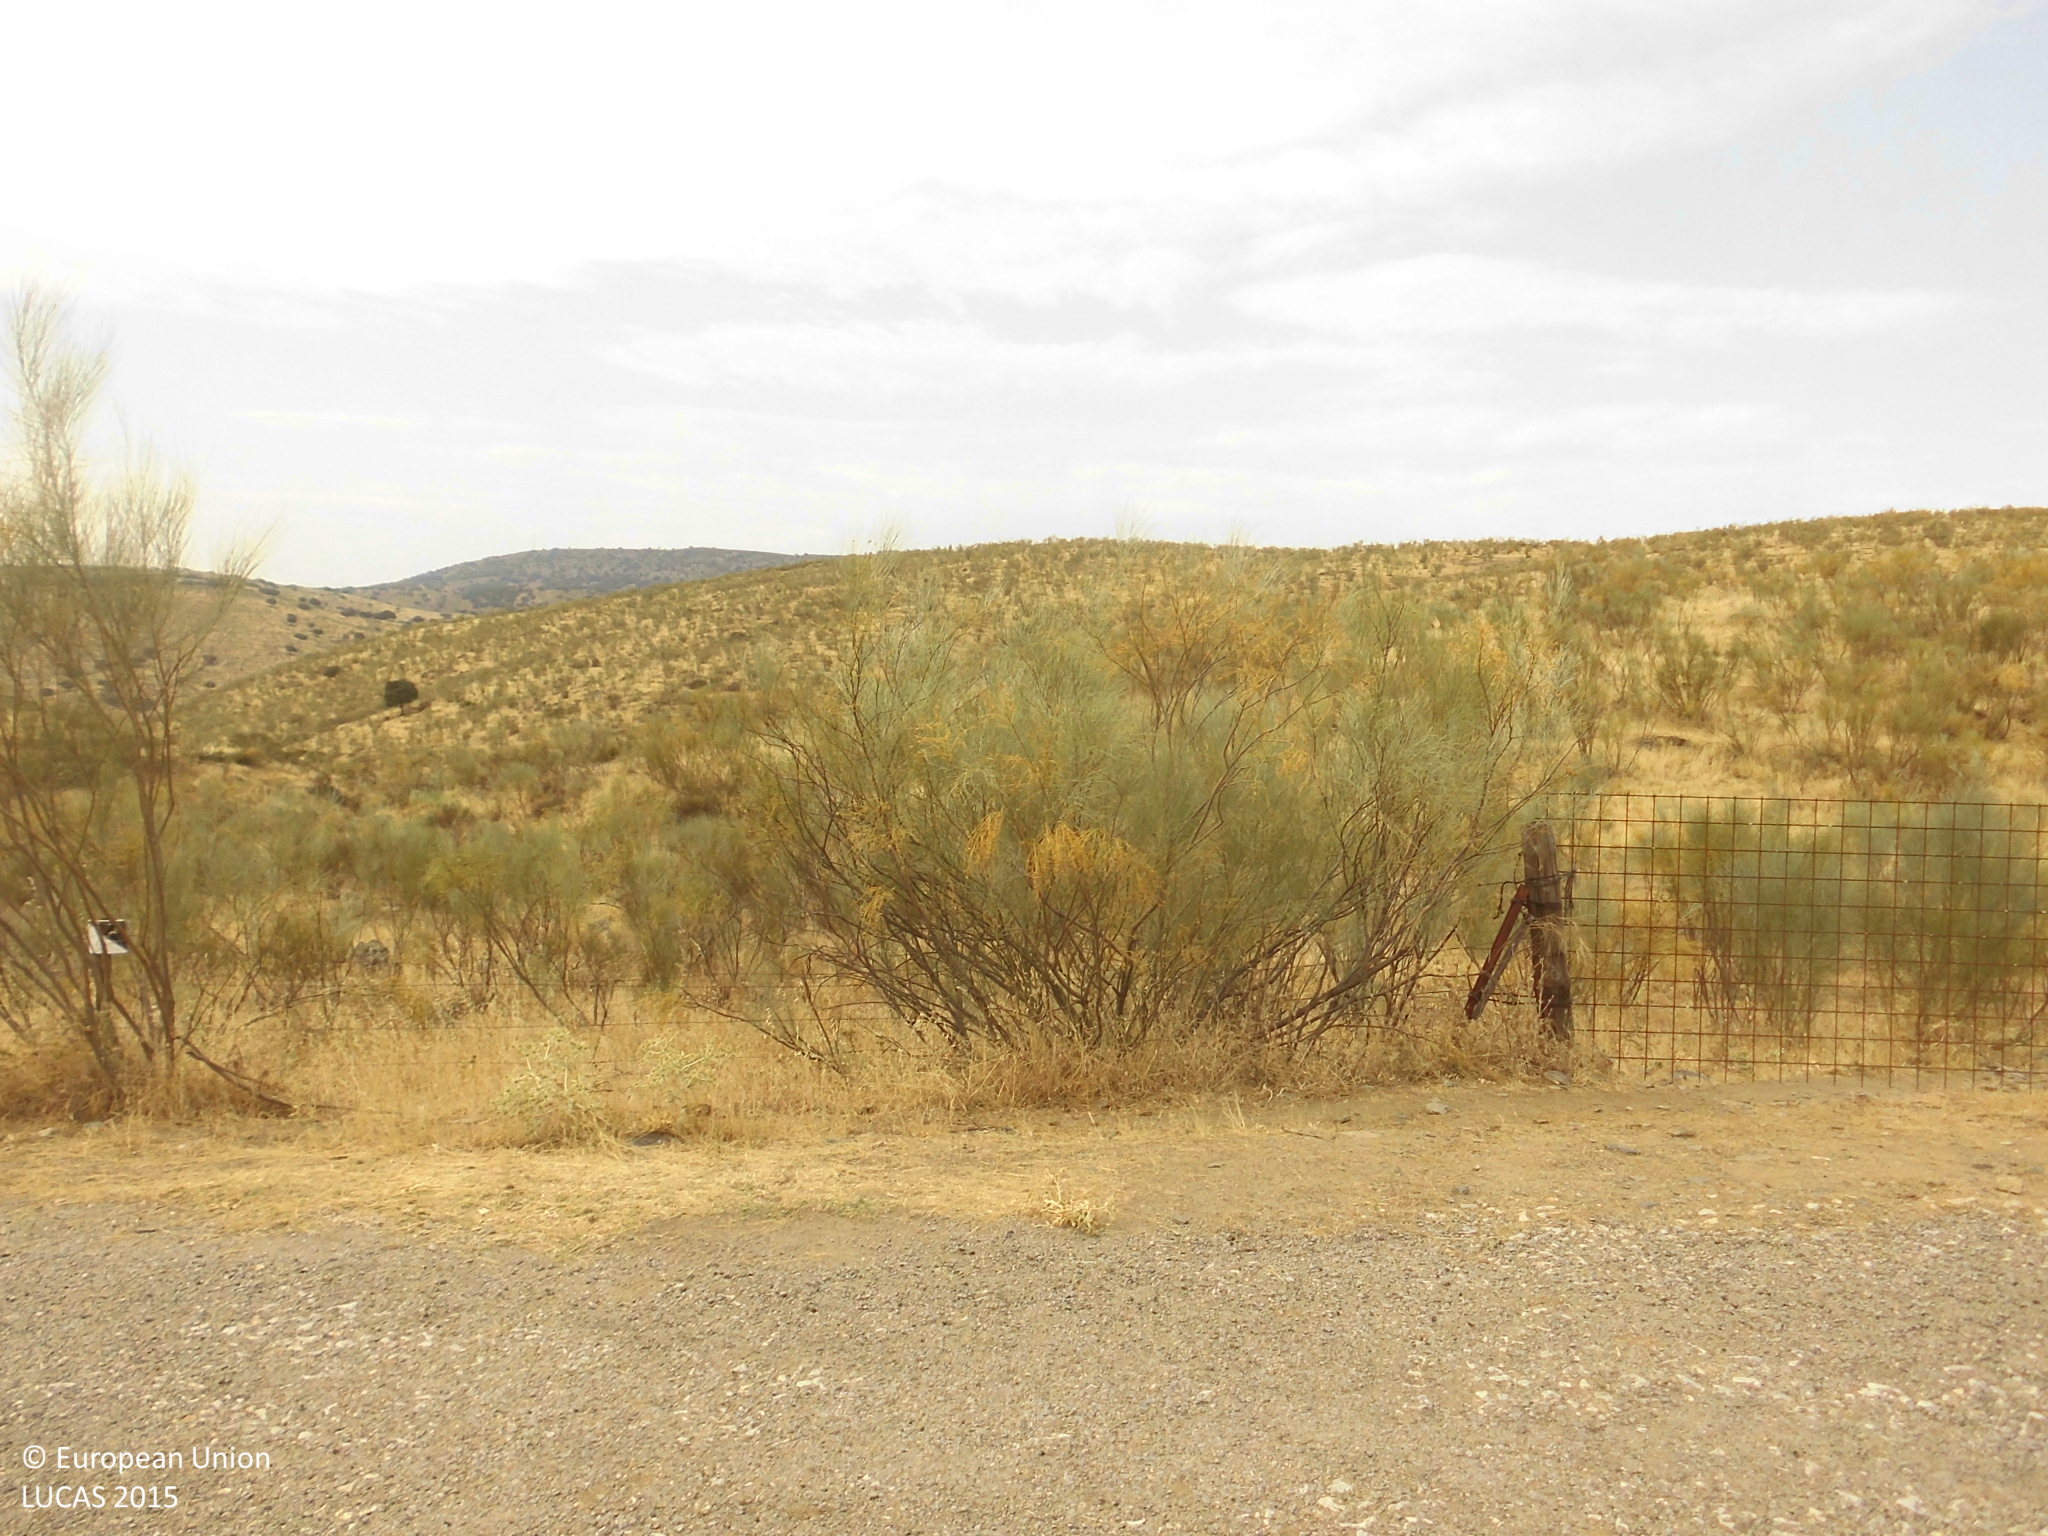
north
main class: Shrubland
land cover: Shrubland without tree cover
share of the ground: 25 - 50 %
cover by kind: shrubs 50 %, herbaceous plants 50 %
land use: Agriculture (excluding fallow land and kitchen gardens)
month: July
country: ES
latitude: 39.7581
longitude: -5.6410
